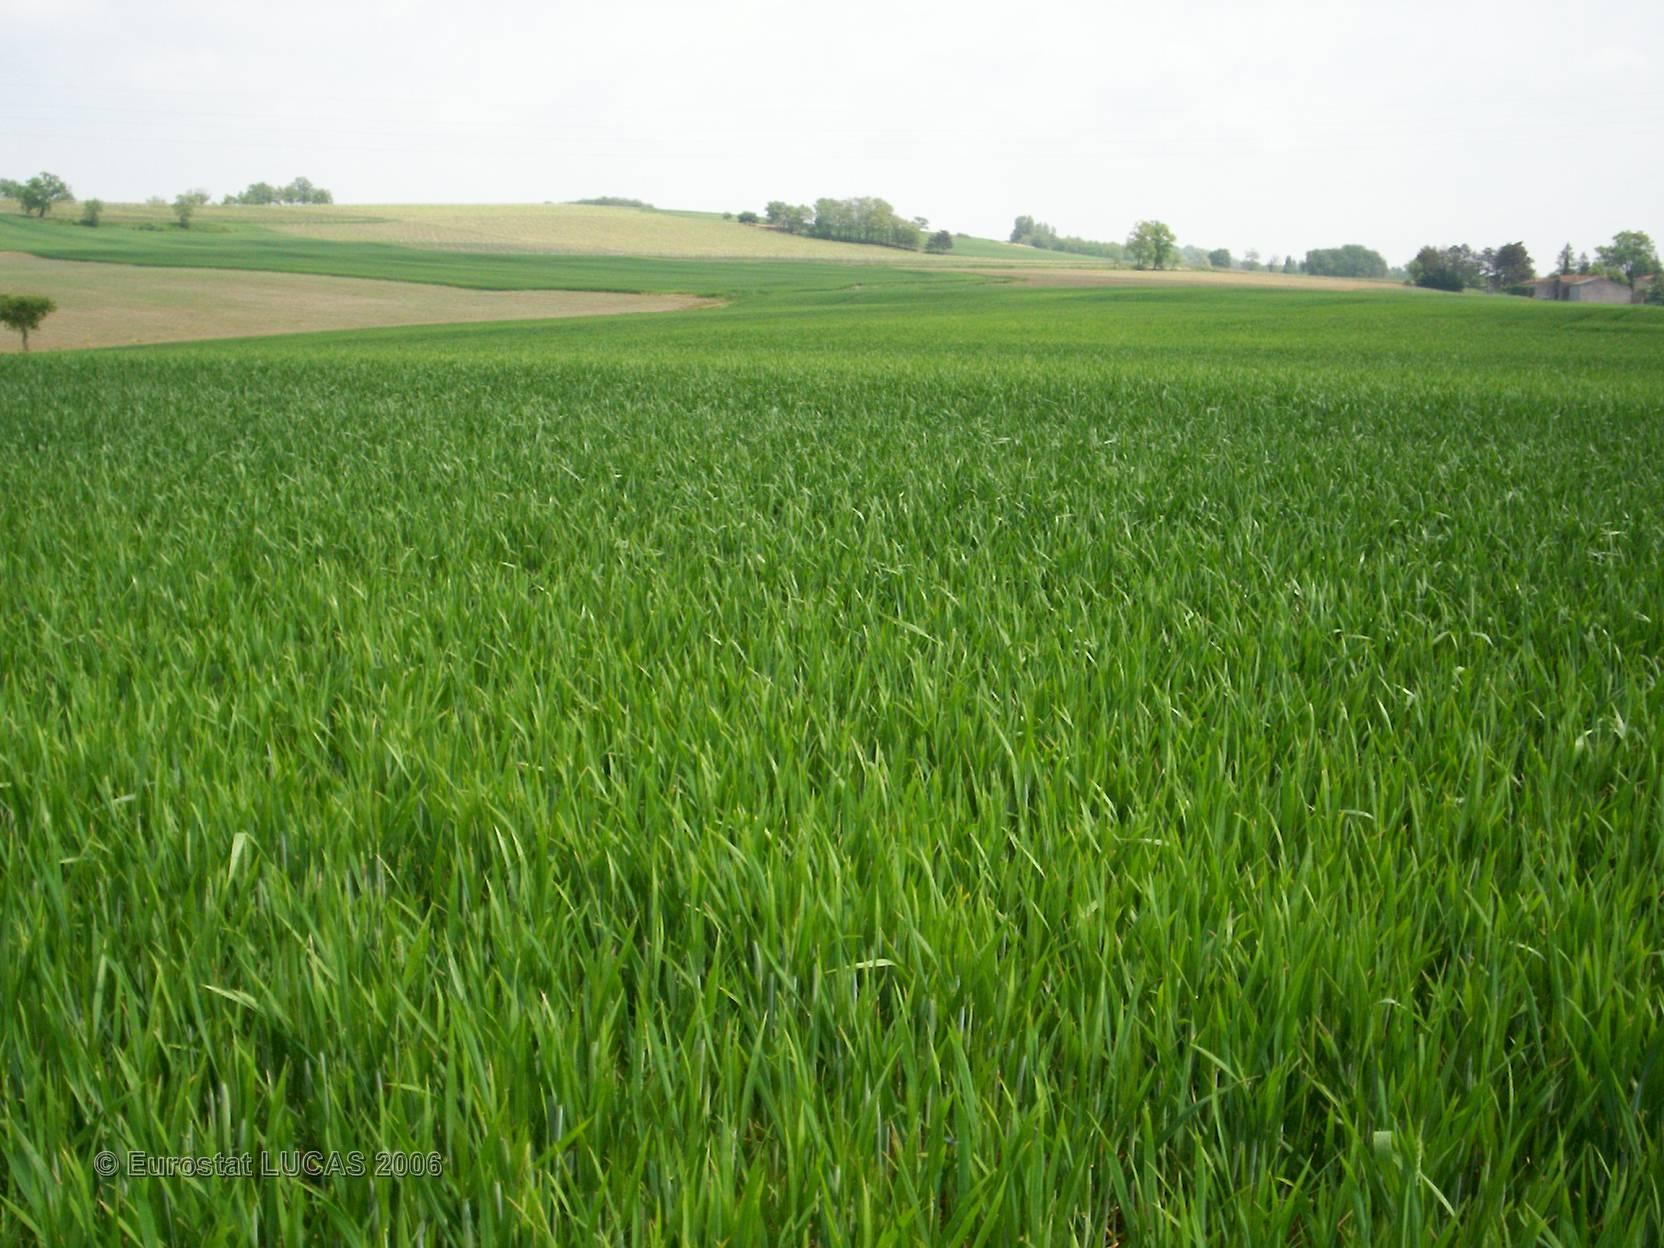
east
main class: Cropland
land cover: Barley
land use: Agriculture (excluding fallow land and kitchen gardens)
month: May
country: FR
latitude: 43.9795
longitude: 0.2320
